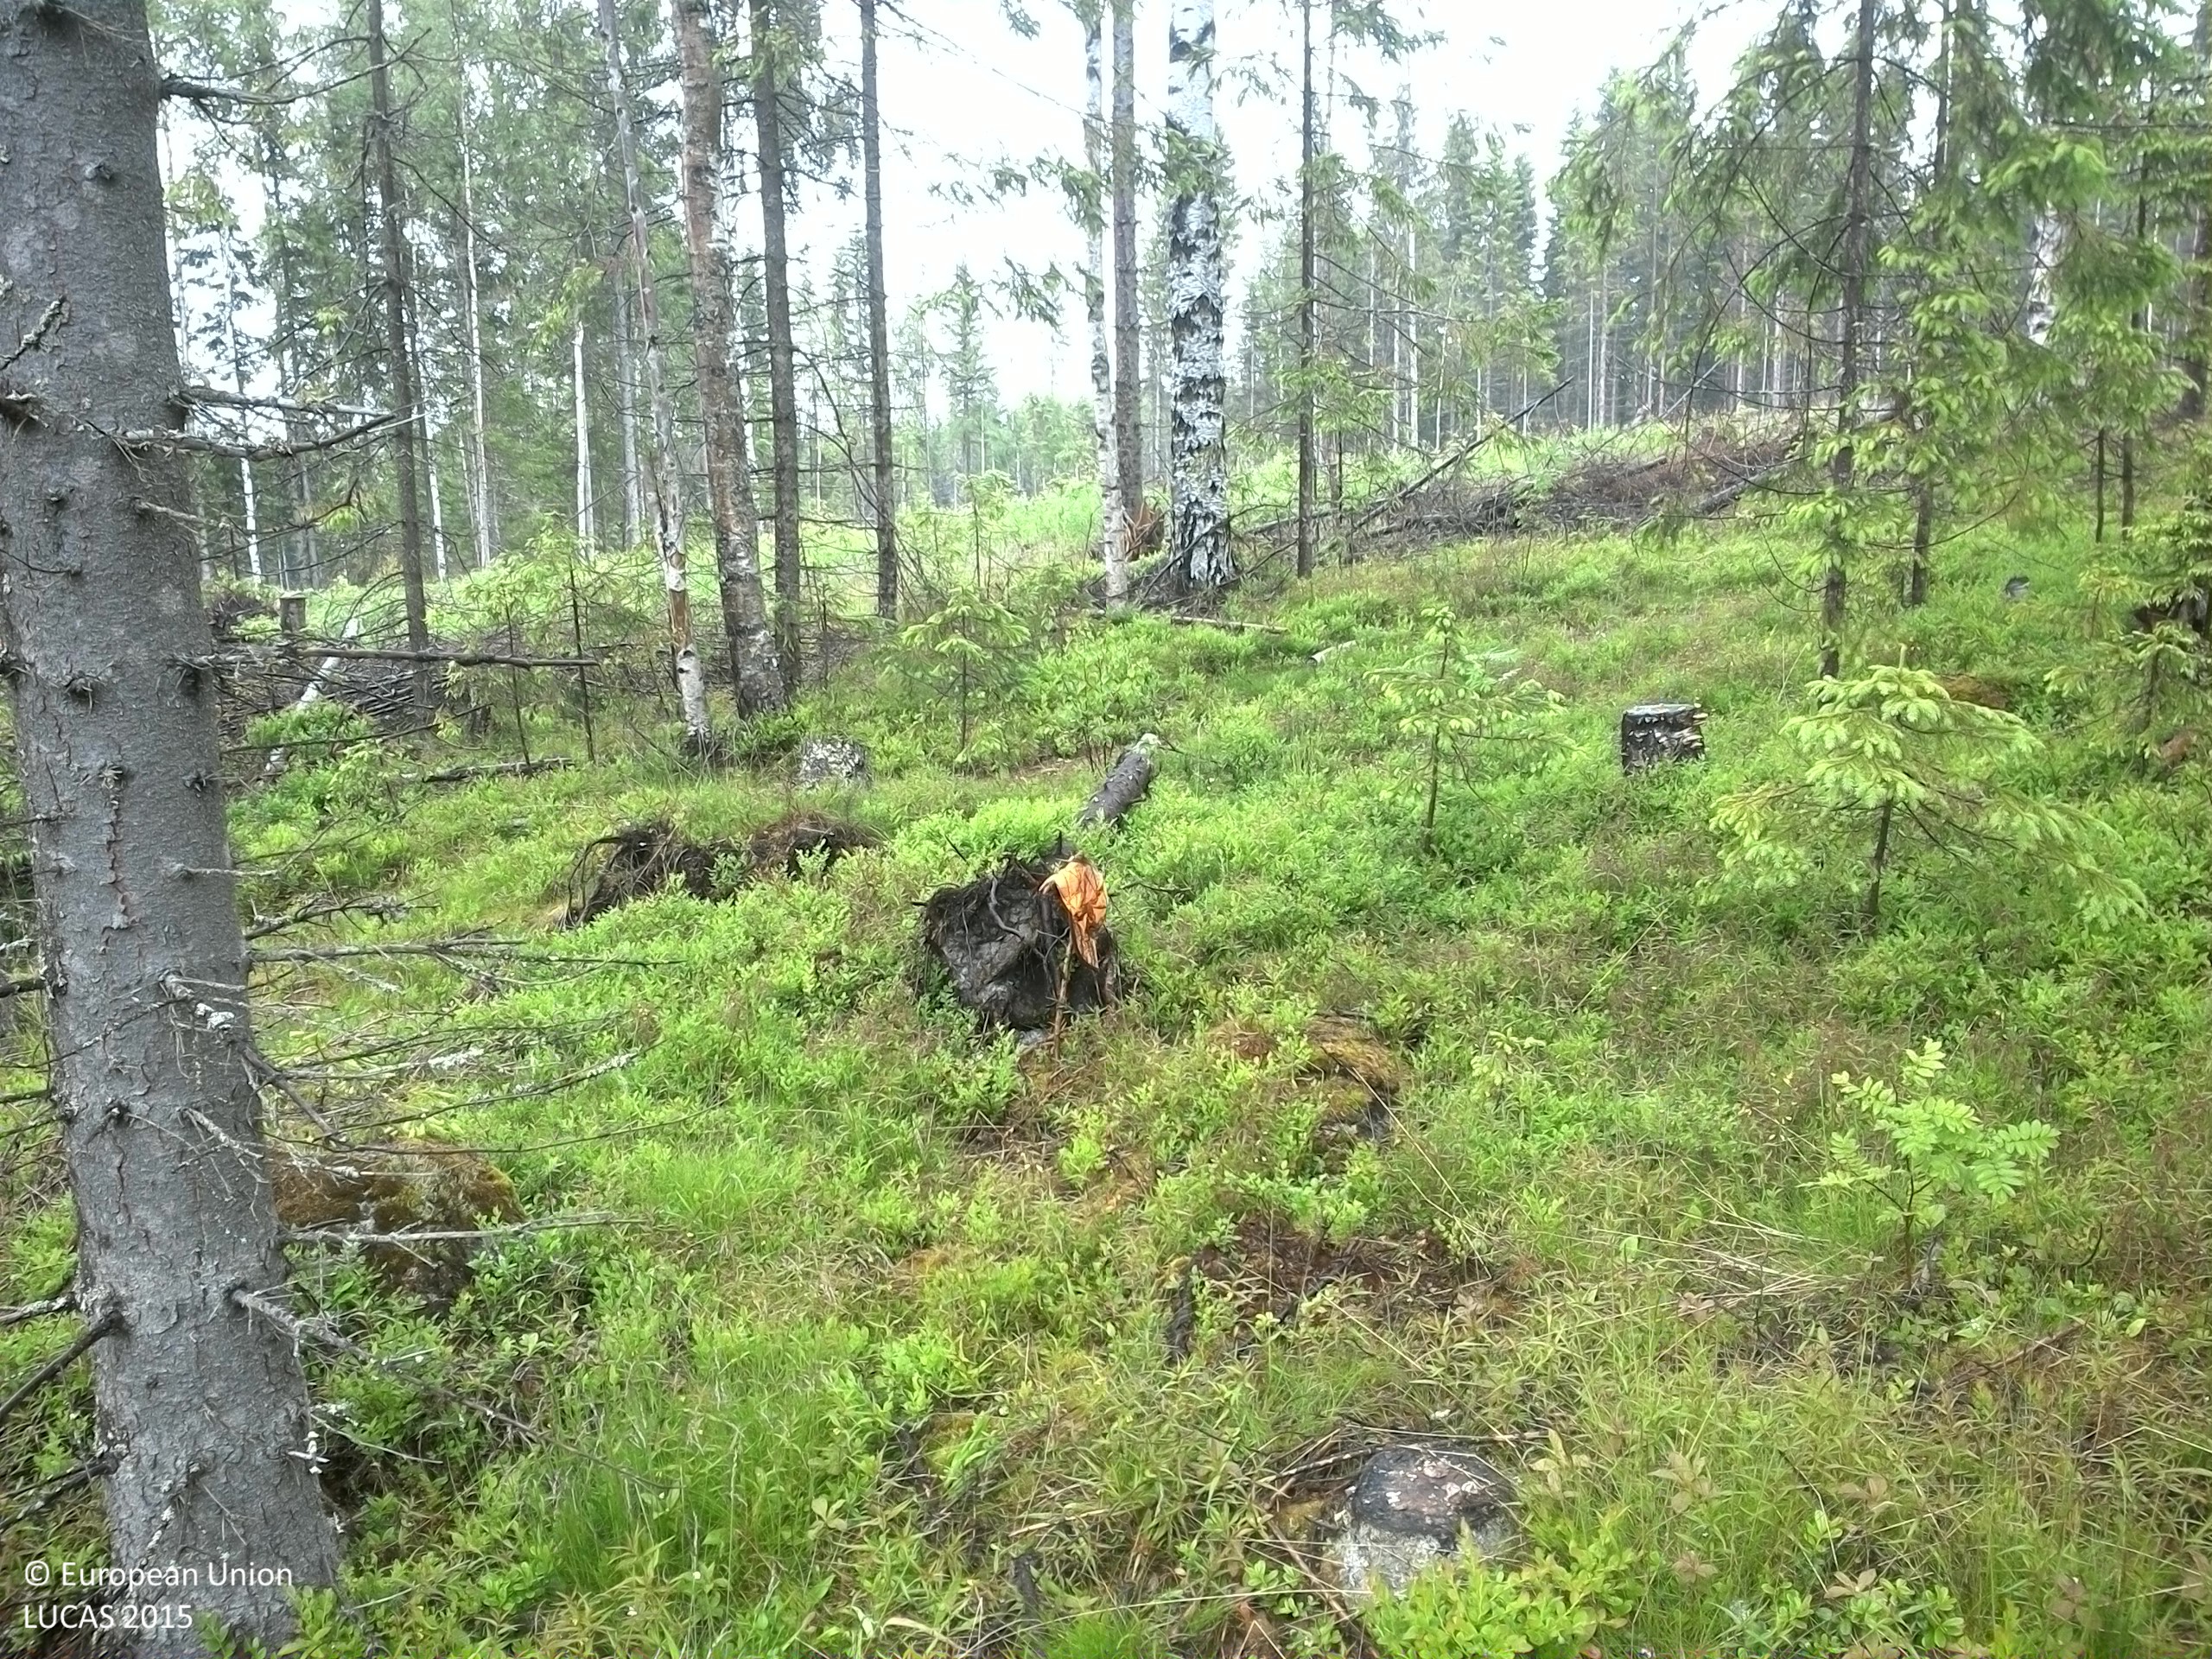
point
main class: Woodland
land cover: Spruce dominated mixed woodland
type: boreal forest
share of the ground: > 75 %
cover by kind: coniferous forest trees 60 %, broadleaved forest trees 20 %, shrubs 15 %, herbaceous plants 5 %
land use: Forestry
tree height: > 5 m
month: June
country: SE
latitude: 62.7669
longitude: 17.9124
